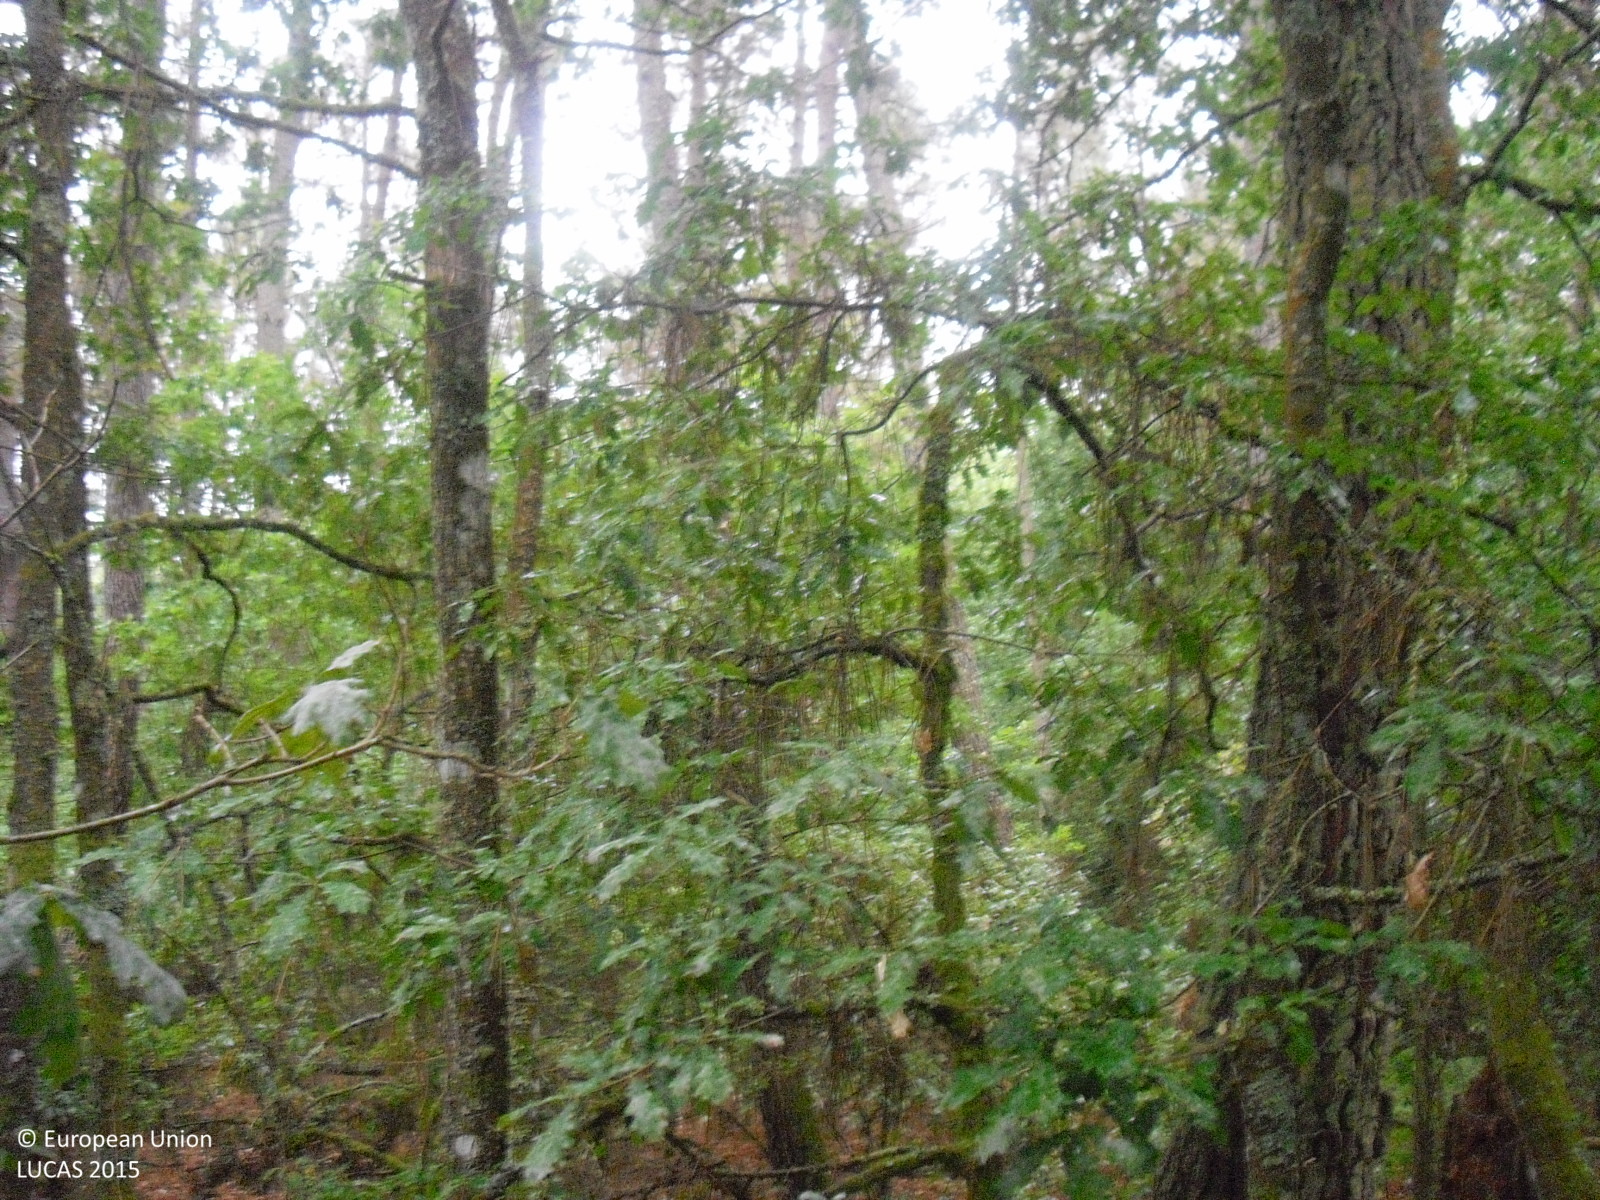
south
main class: Woodland
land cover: Pine dominated mixed woodland
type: hemiboreal forest and nemoral coniferous forest and mixed broadleaved-coniferous forest
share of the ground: > 75 %
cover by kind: coniferous forest trees 60 %, broadleaved forest trees 20 %, shrubs 20 %
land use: Forestry
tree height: > 5 m
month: July
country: ES
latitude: 42.3026
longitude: -7.6725
